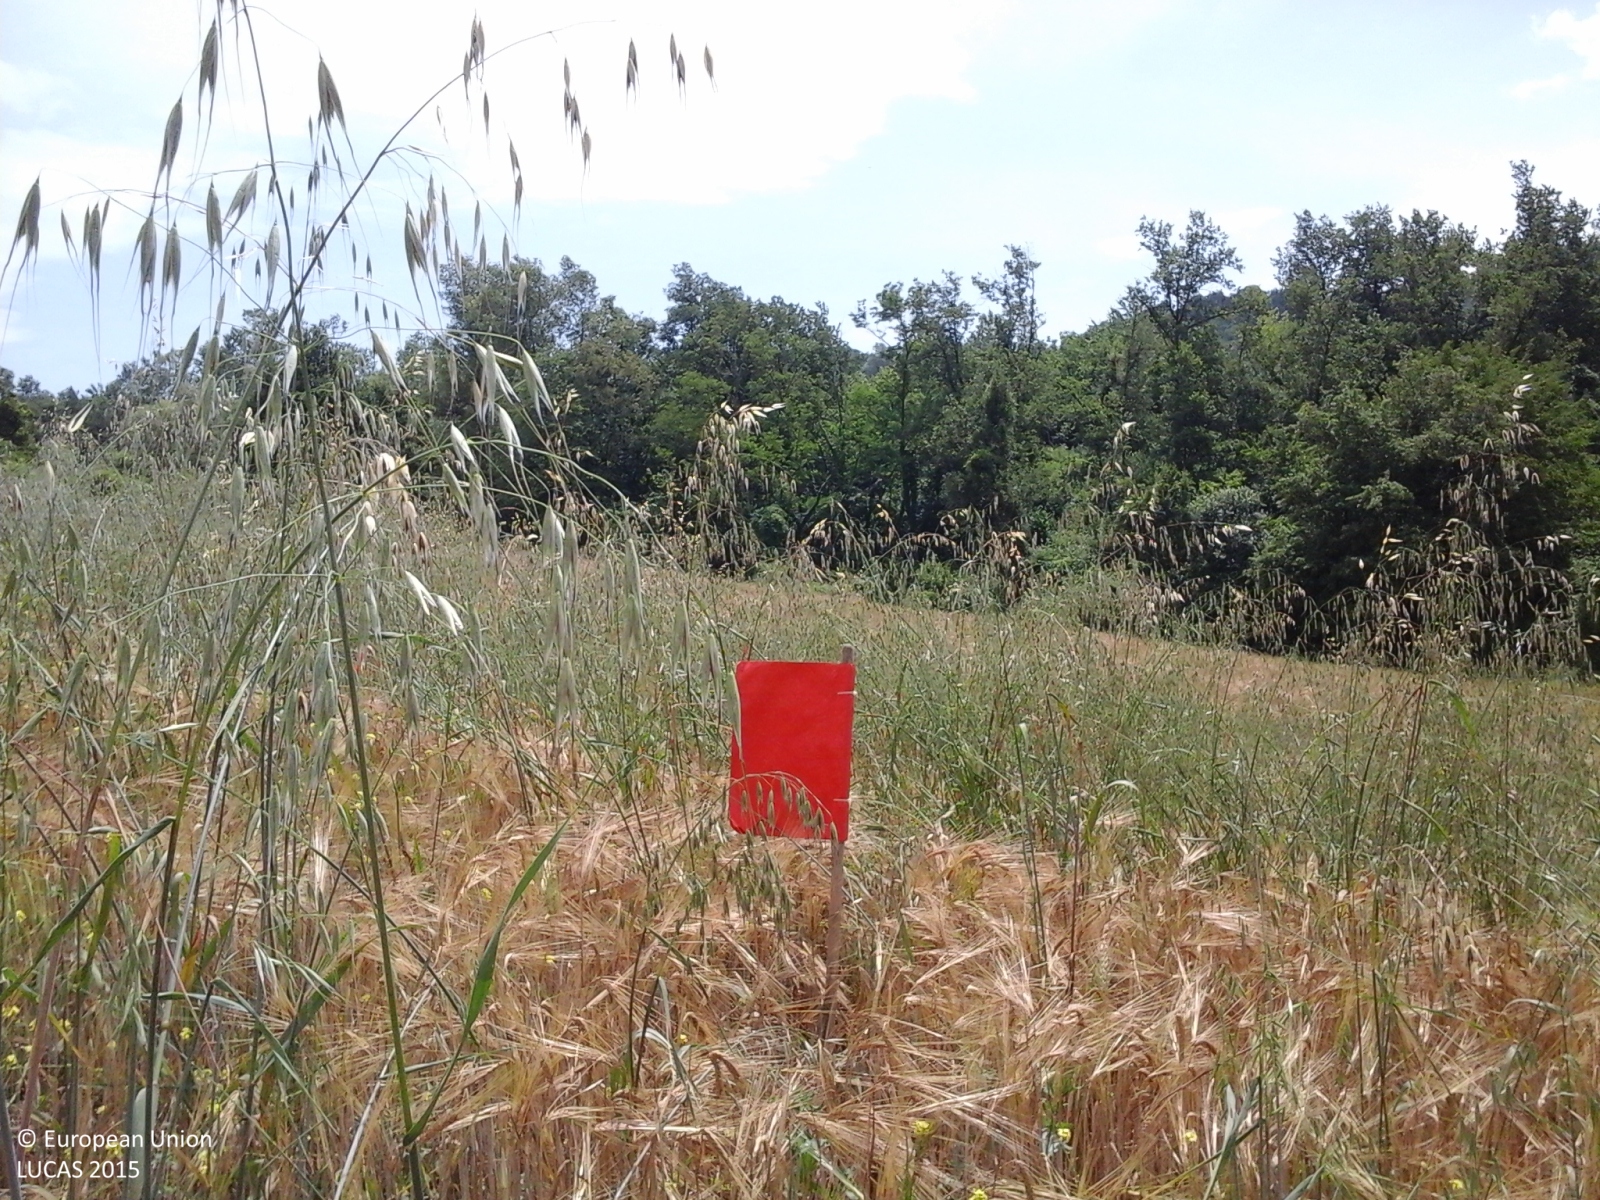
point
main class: Cropland
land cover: Barley
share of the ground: > 75 %
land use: Agriculture (excluding fallow land and kitchen gardens)
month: June
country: IT
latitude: 44.8189
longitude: 9.6845
